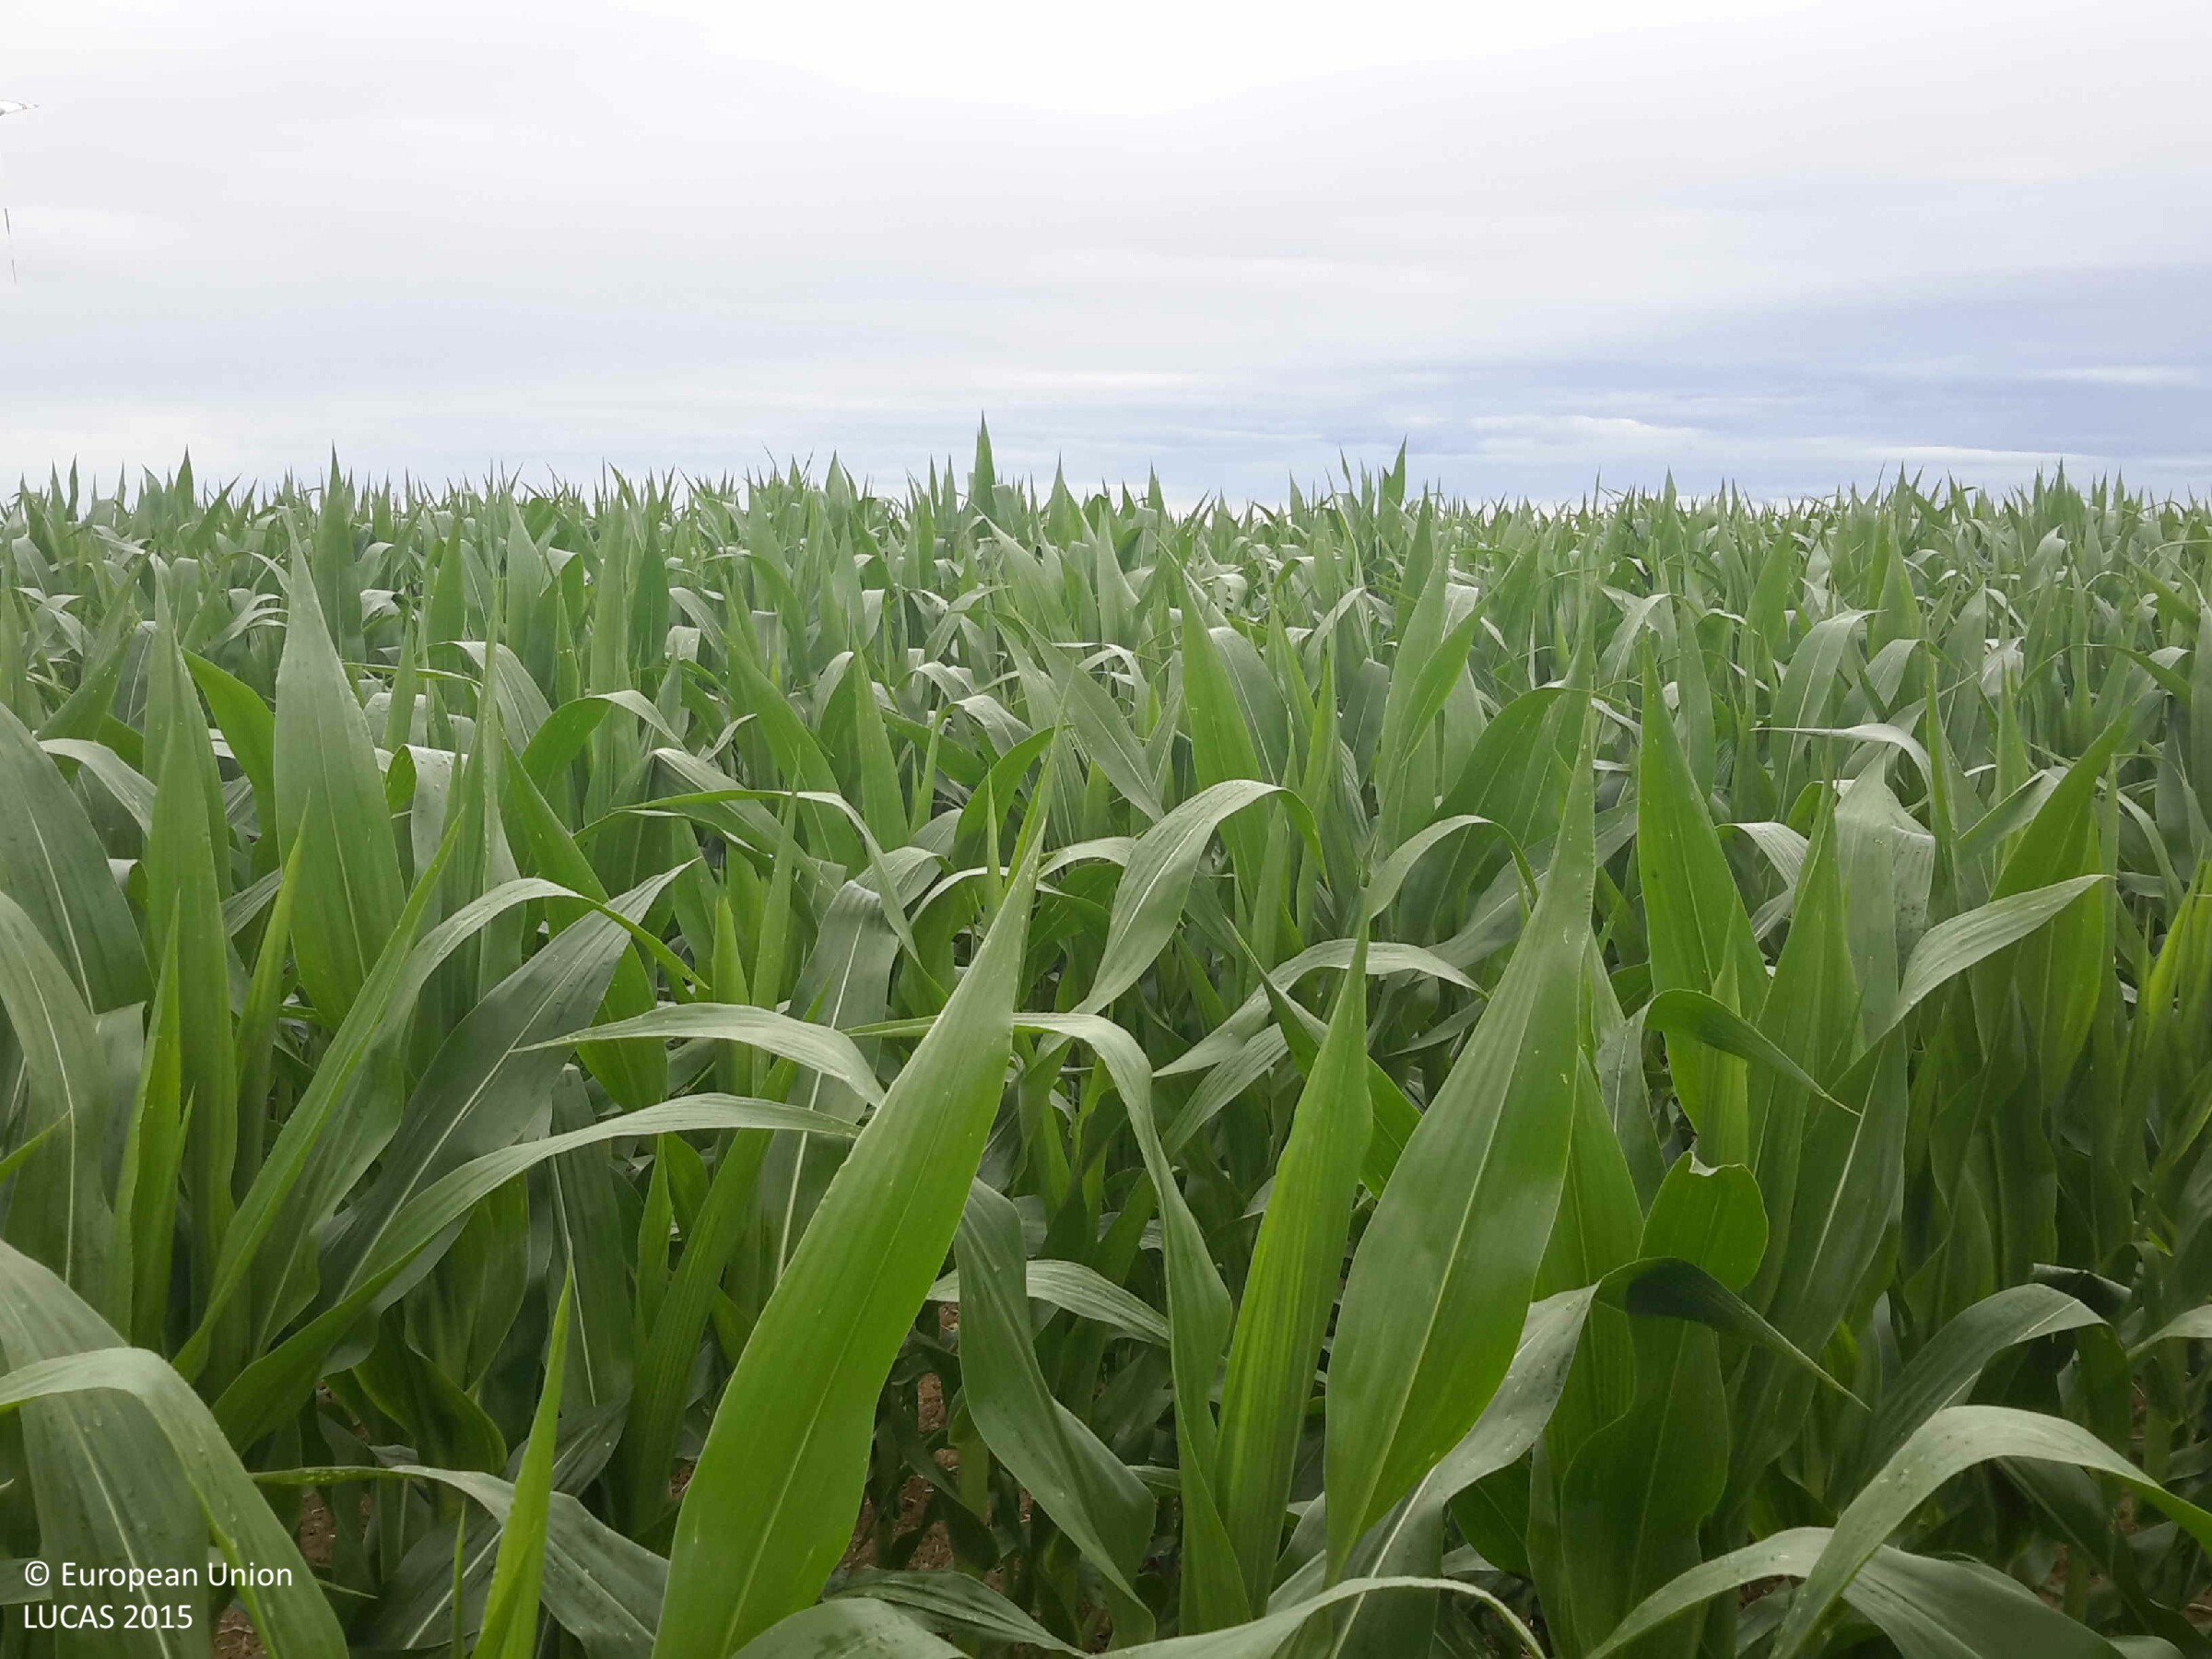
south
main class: Cropland
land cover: Maize
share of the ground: > 75 %
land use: Agriculture (excluding fallow land and kitchen gardens)
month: July
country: HU
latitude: 47.5655
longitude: 16.7438
